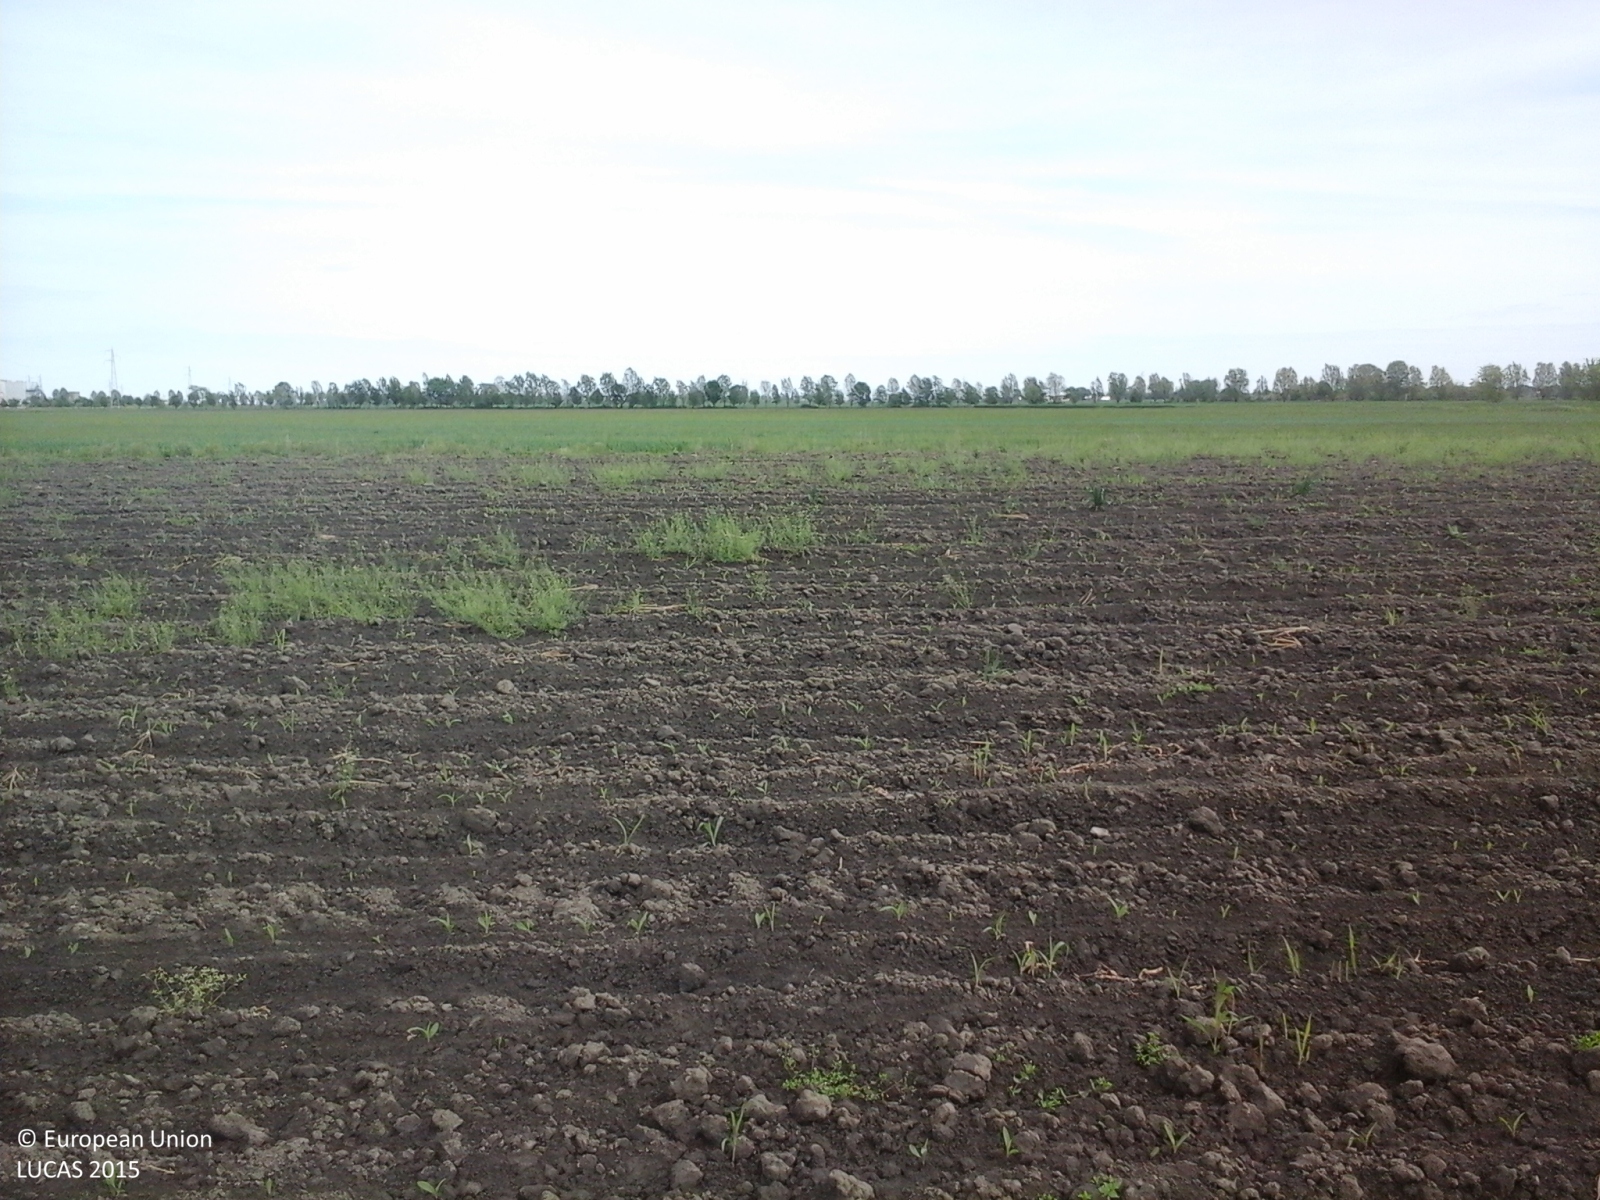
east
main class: Cropland
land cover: Maize
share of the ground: < 10 %
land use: Agriculture (excluding fallow land and kitchen gardens)
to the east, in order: Maize; Grass margins; Ditches and canals; Grass margins; Common wheat; Ditches and canals; Common wheat; Ditches and canals; Common wheat; Ditches and canals
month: April
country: IT
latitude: 45.0544
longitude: 11.9139
